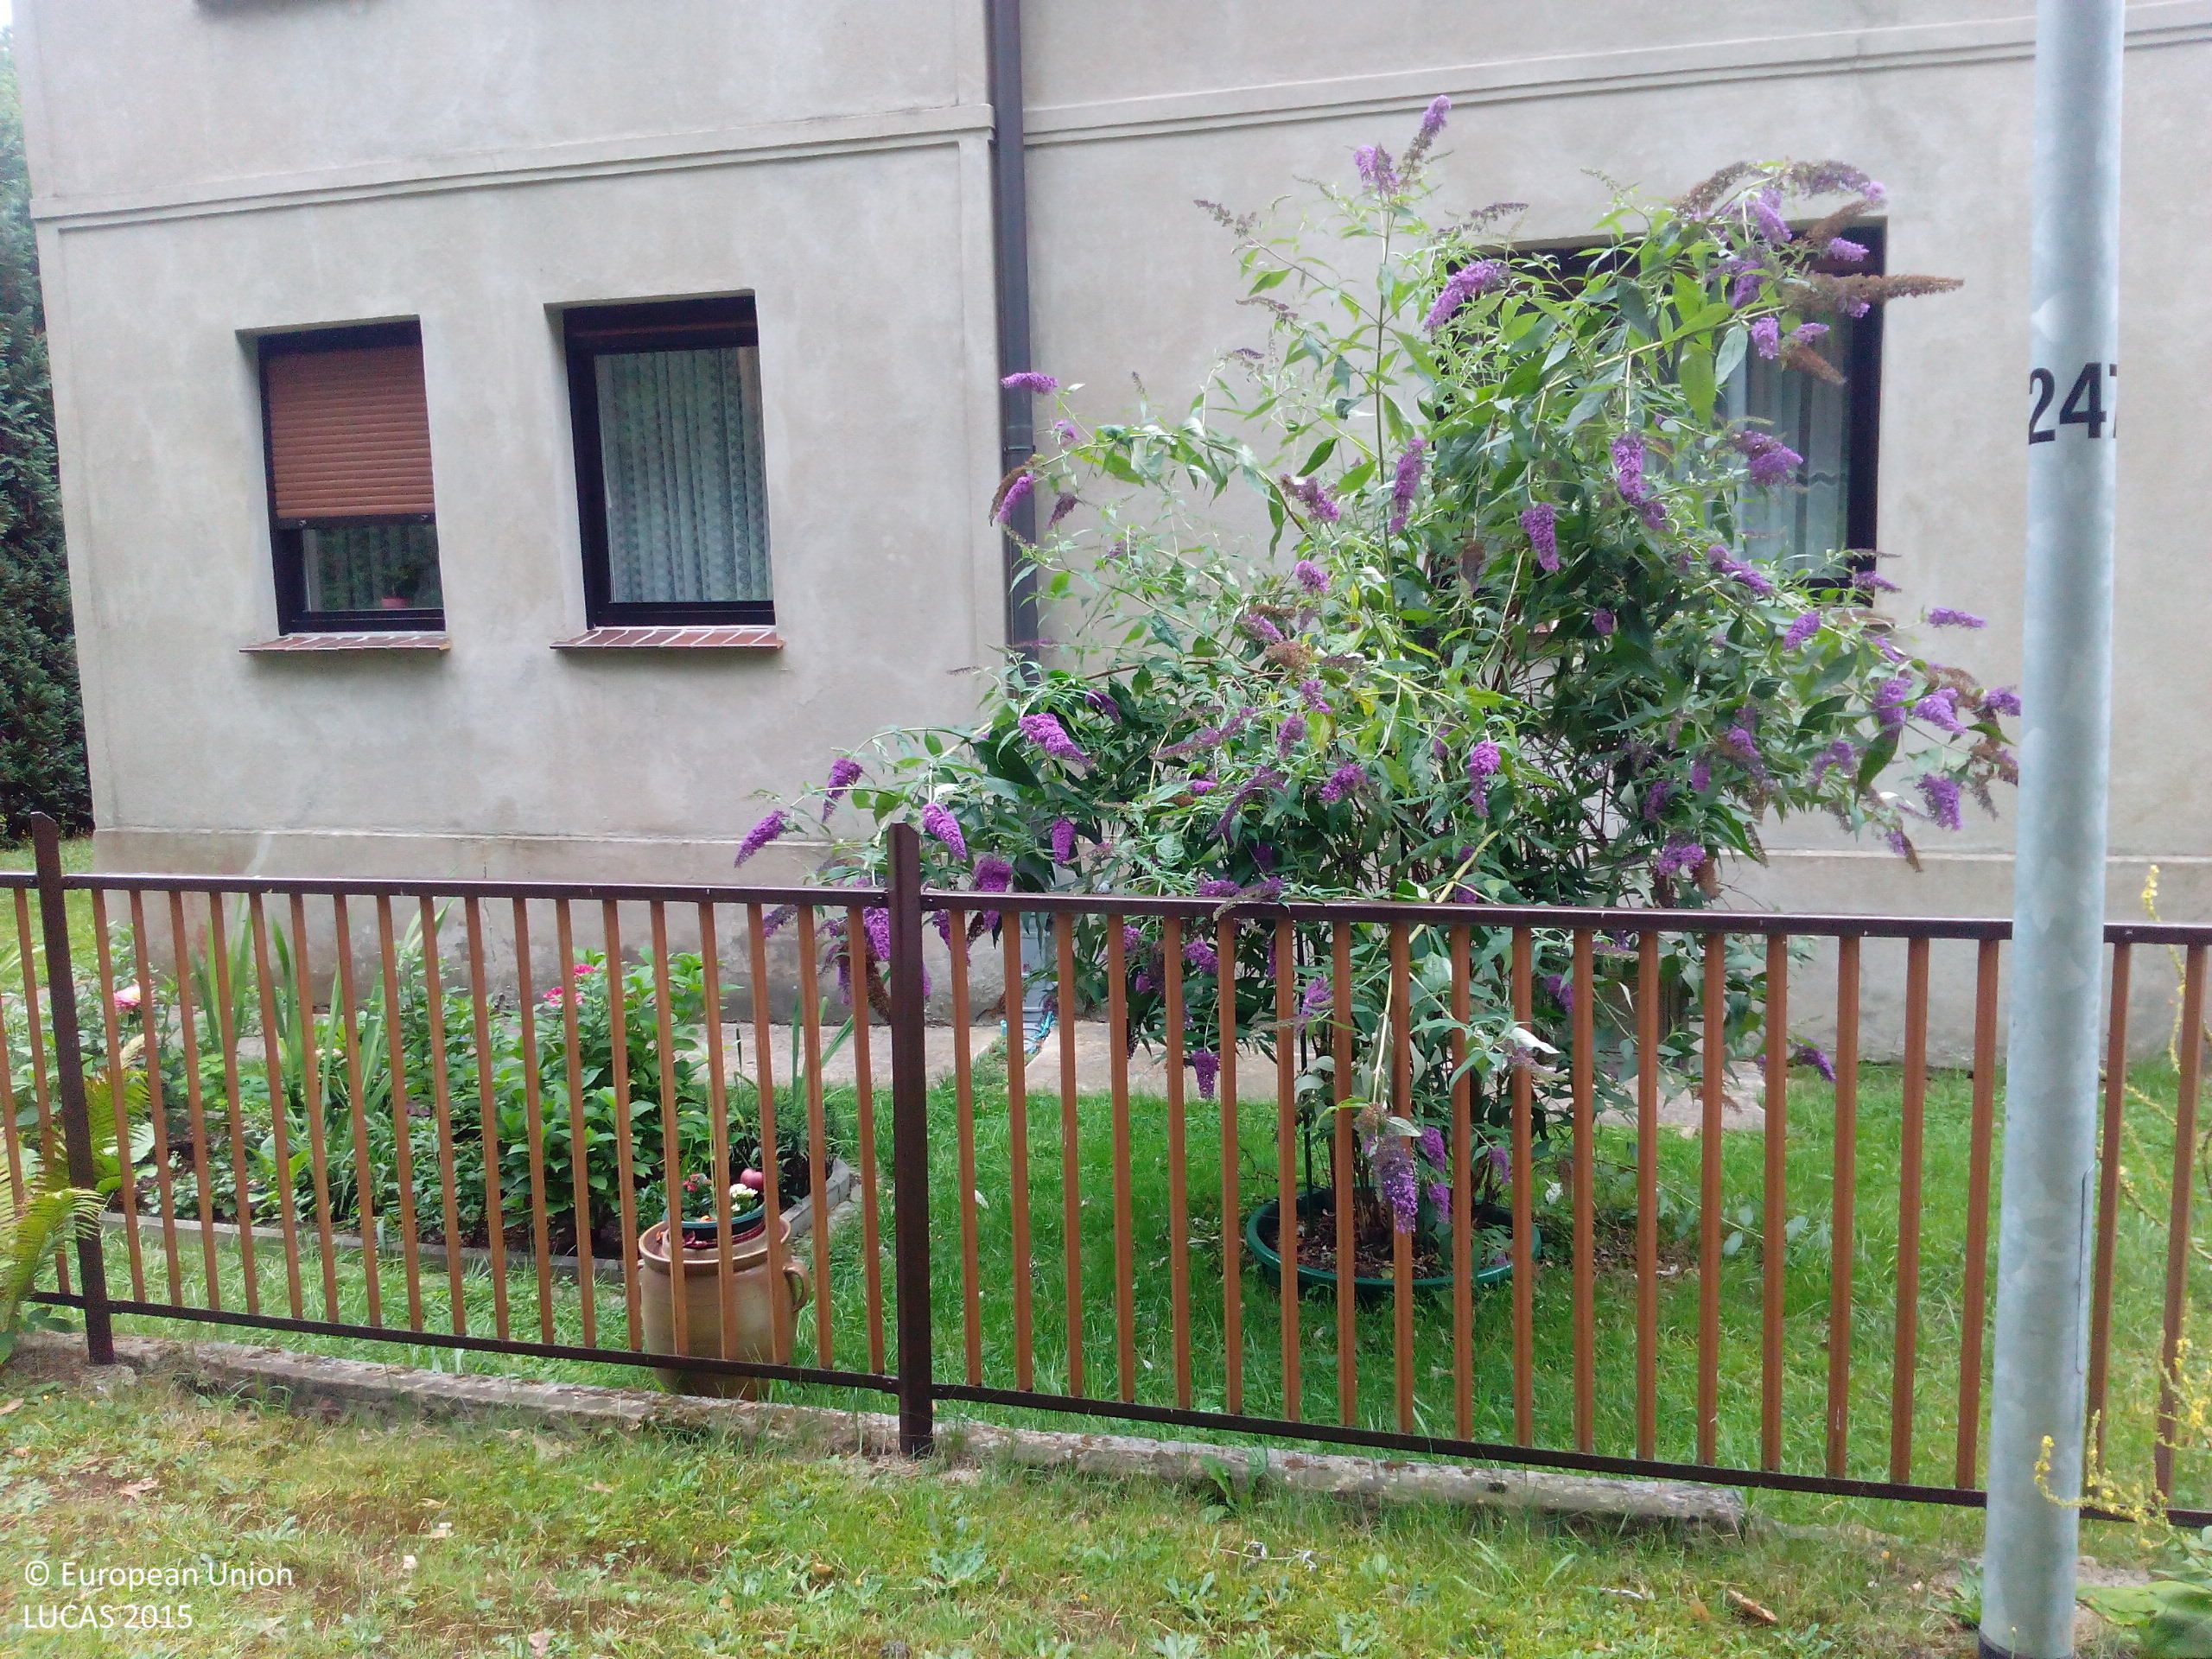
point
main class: Shrubland
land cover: Shrubland without tree cover
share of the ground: 10 - 25 %
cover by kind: herbaceous plants 80 %, shrubs 15 %, consolidated bare surface 5 %
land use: Residential
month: July
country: DE
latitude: 51.4457
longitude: 14.0154
